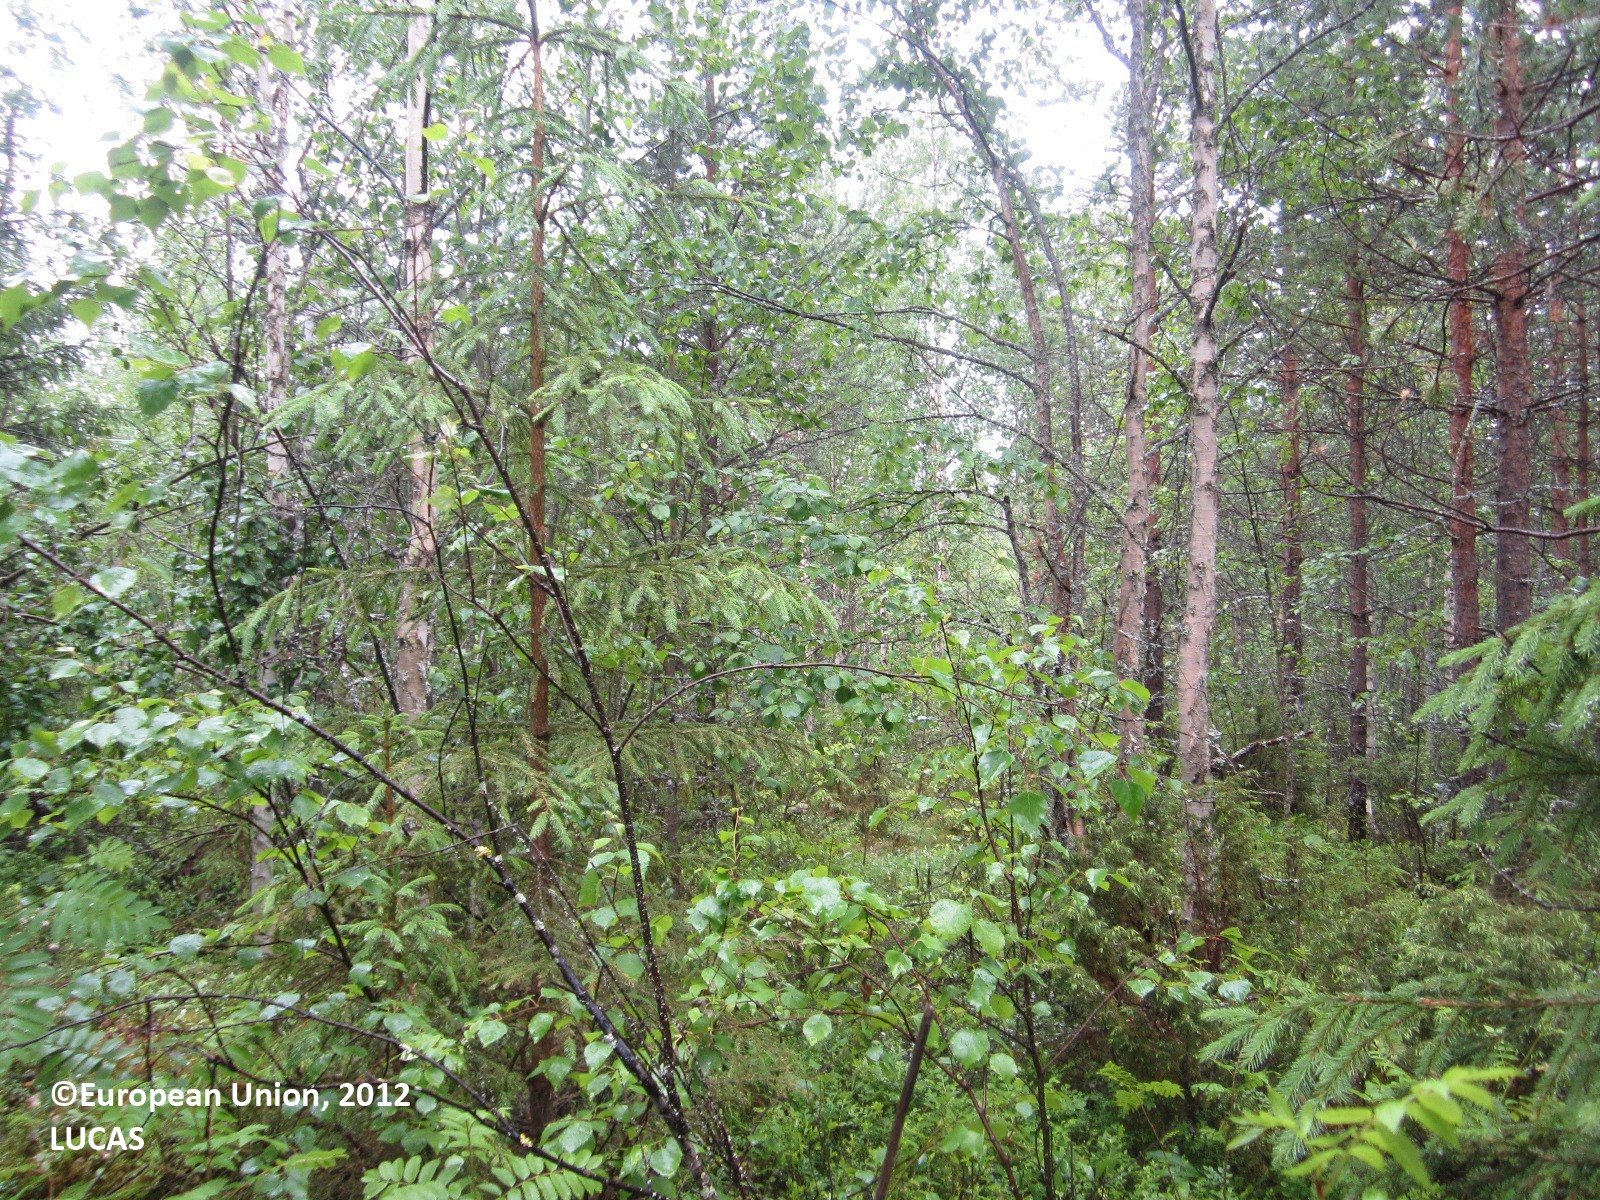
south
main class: Woodland
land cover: Pine dominated mixed woodland
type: boreal forest
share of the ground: > 75 %
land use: Forestry
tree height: > 5 m
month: June
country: FI
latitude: 64.5961
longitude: 29.3211
